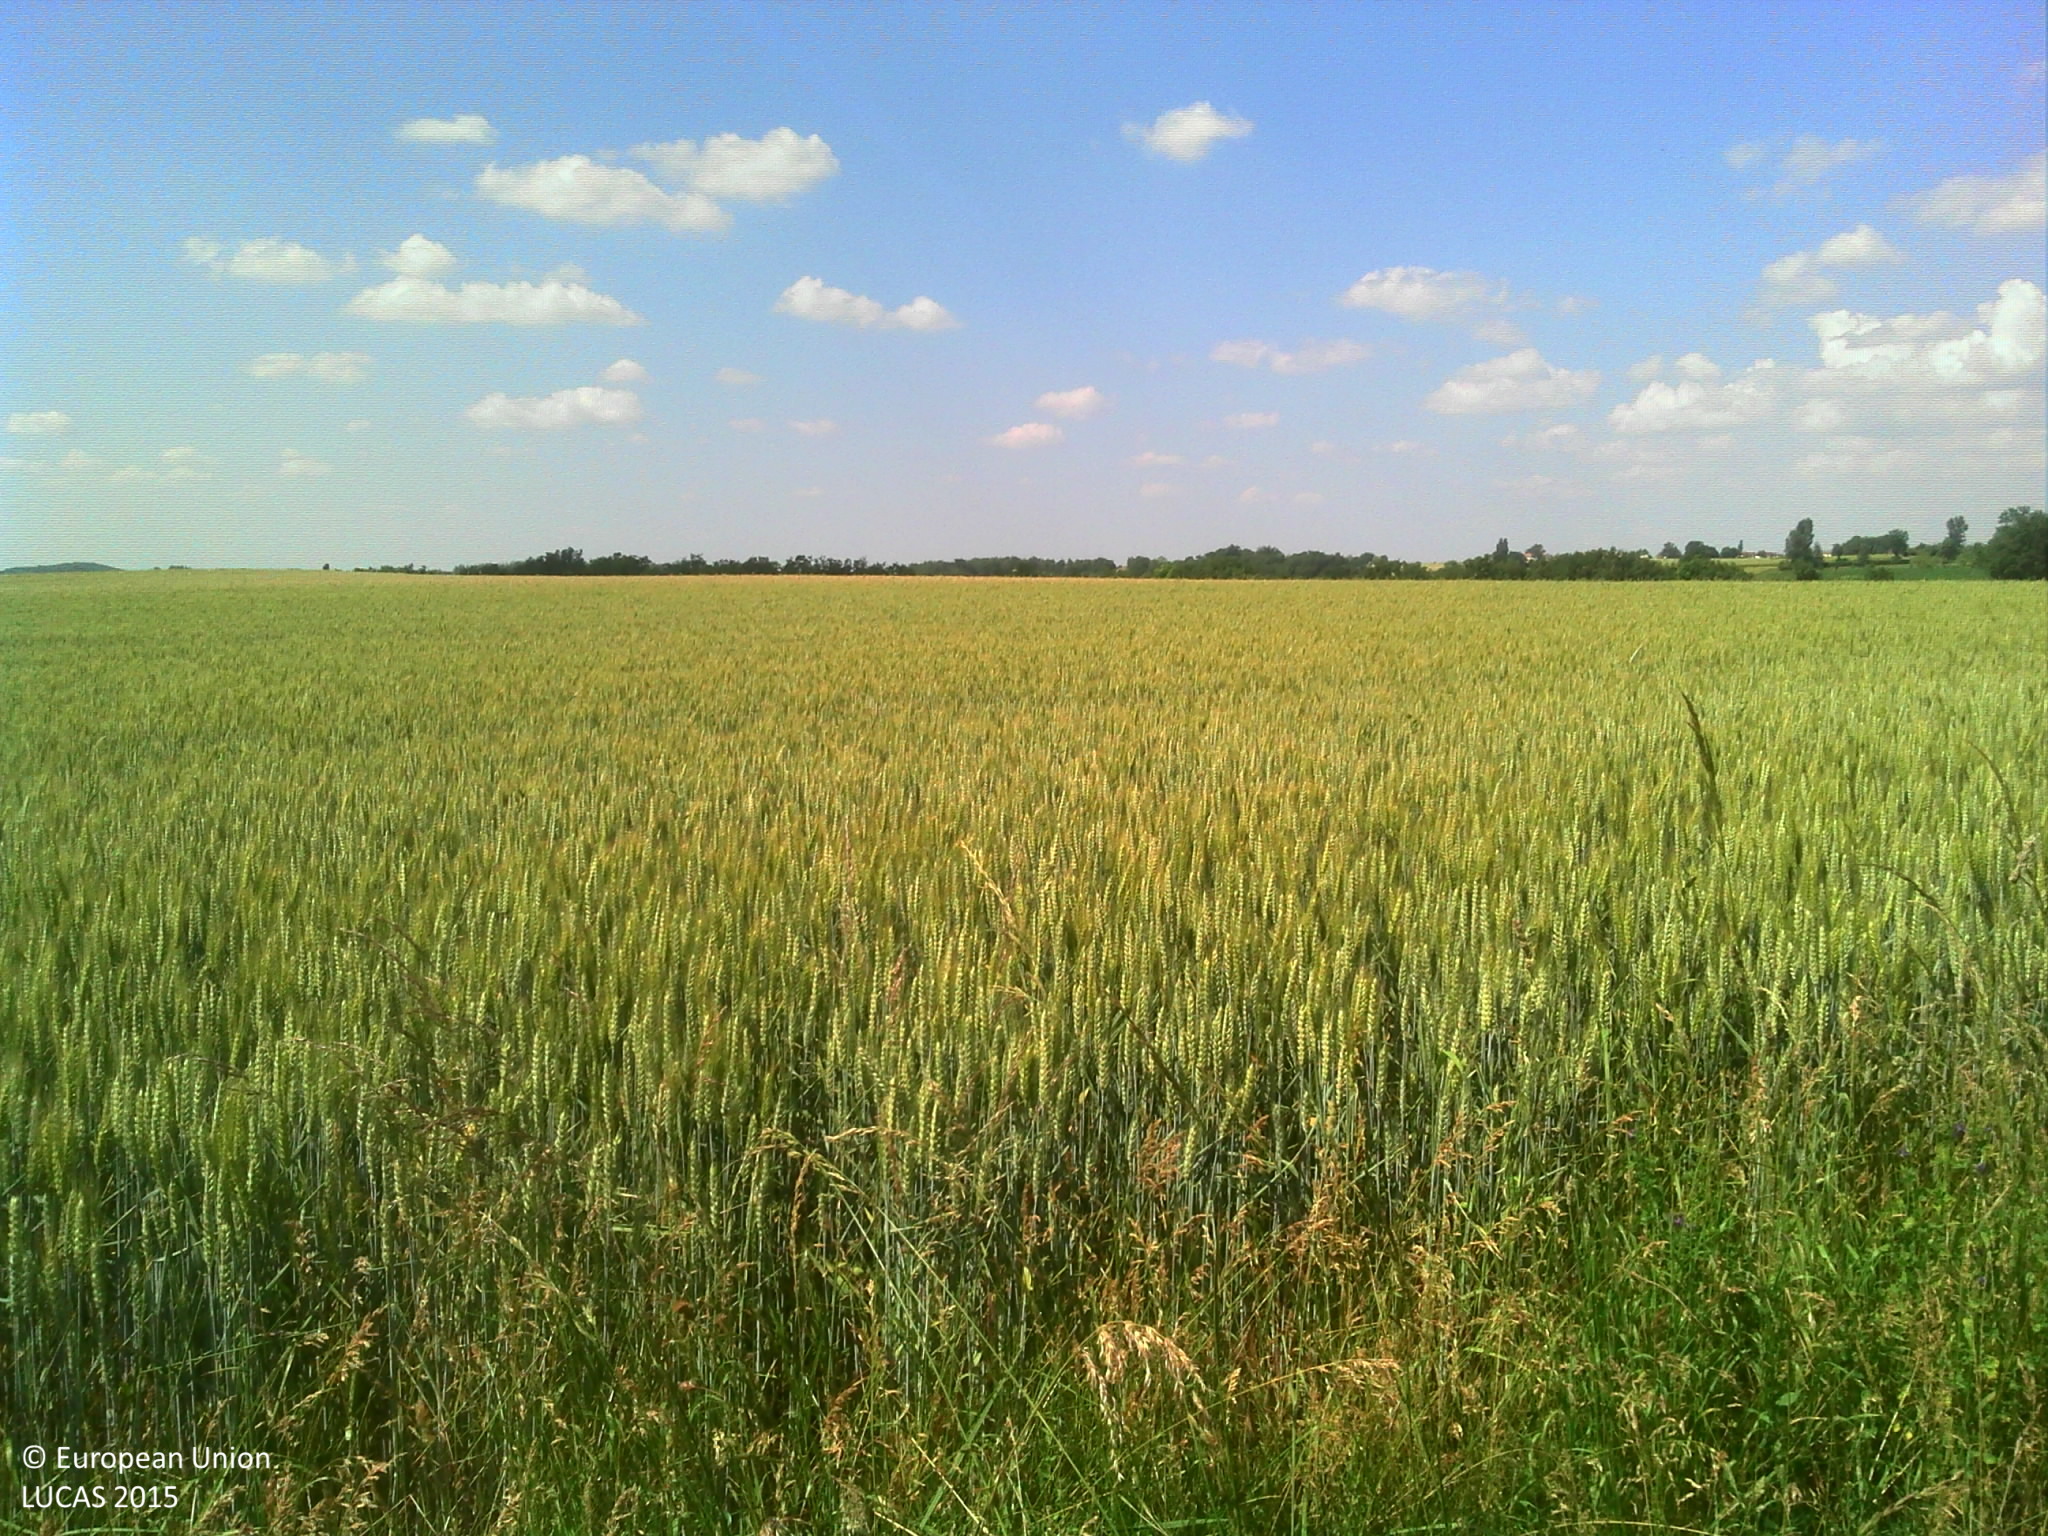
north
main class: Cropland
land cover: Common wheat
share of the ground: > 75 %
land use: Agriculture (excluding fallow land and kitchen gardens)
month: June
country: FR
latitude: 43.8501
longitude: 2.1049
